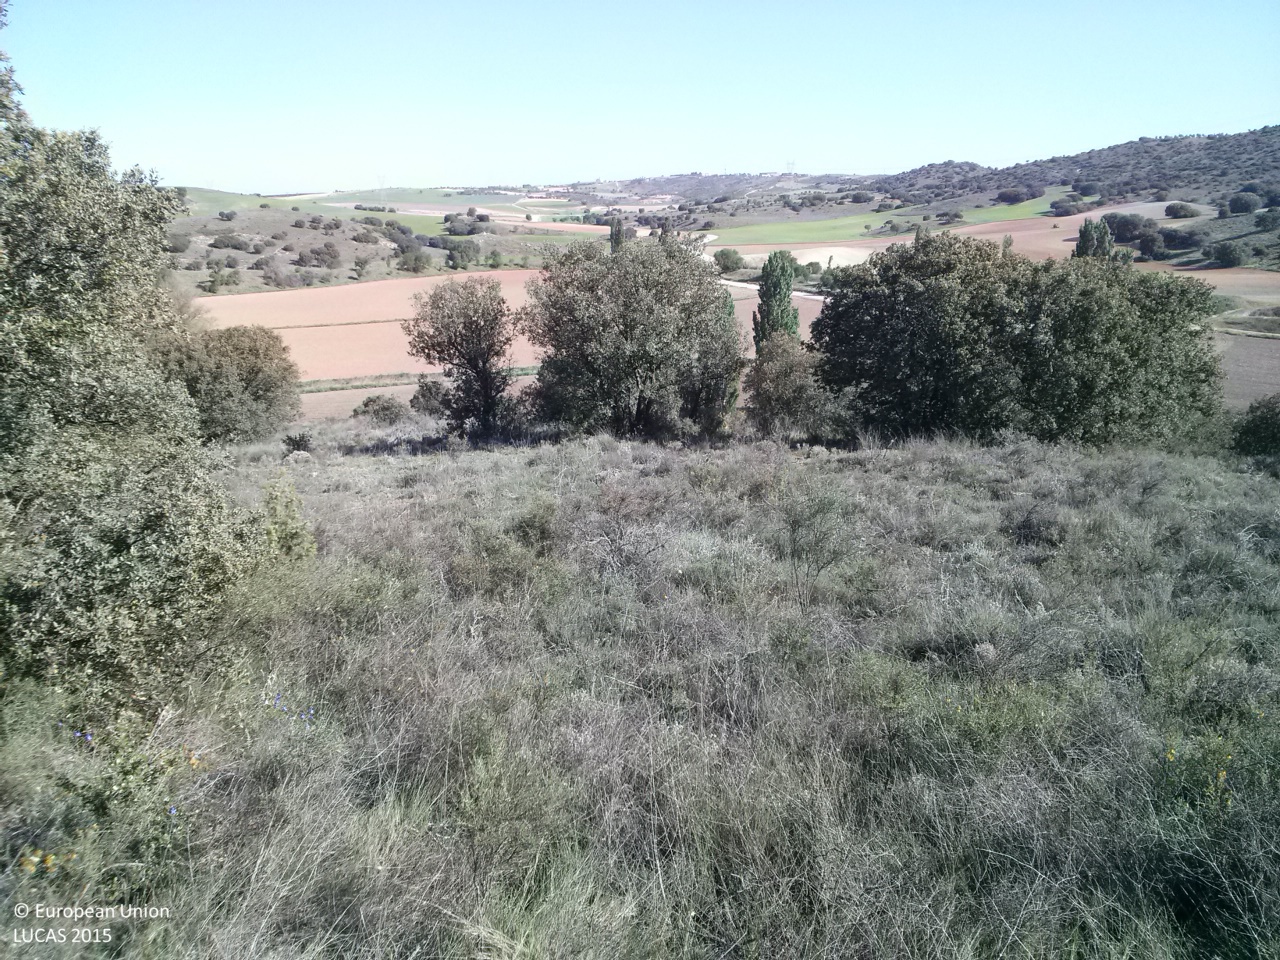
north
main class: Woodland
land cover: Broadleaved woodland
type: broadleaved evergreen forest
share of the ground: 10 - 25 %
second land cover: Shrubland without tree cover
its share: 50 - 75 %
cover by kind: shrubs 60 %, herbaceous plants 25 %, broadleaved forest trees 15 %
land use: Forestry
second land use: Agriculture (excluding fallow land and kitchen gardens)
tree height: < 5 m
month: May
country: ES
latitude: 39.8824
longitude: -2.8007
